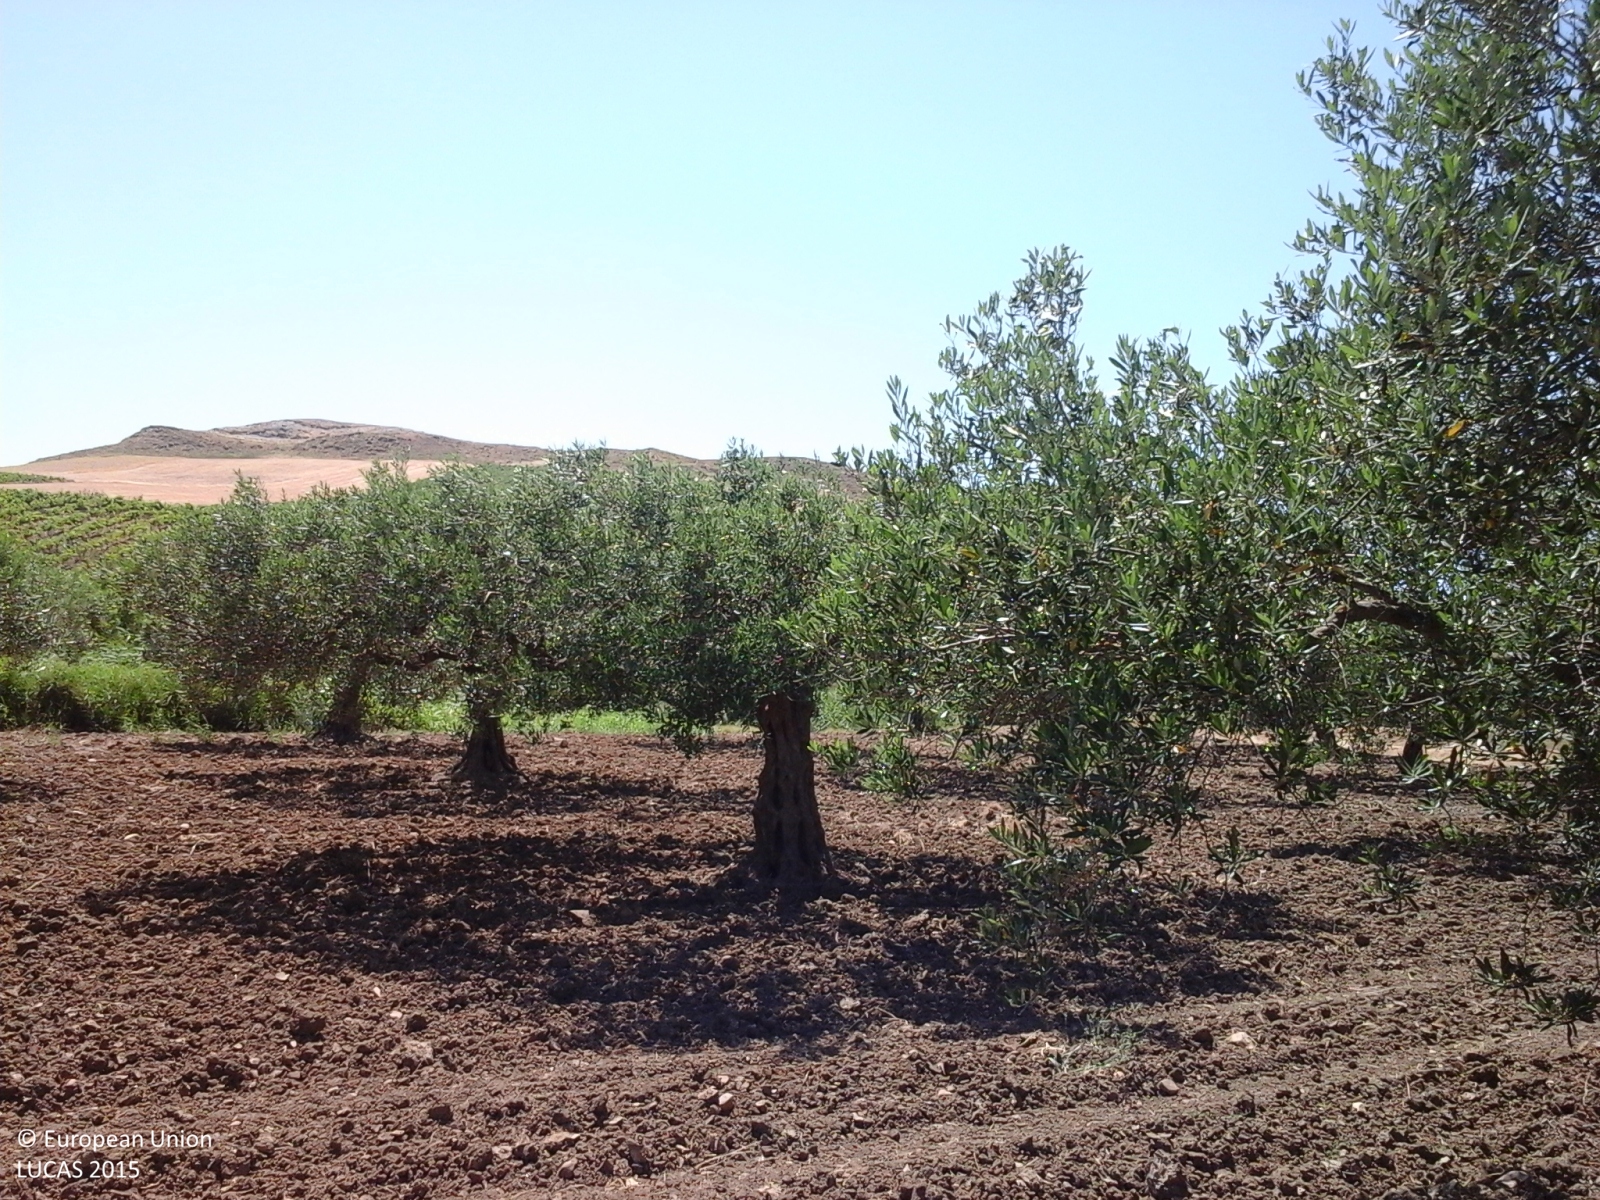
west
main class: Cropland
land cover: Olive groves
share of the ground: 50 - 75 %
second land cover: Other bare soil
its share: > 75 %
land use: Agriculture (excluding fallow land and kitchen gardens)
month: June
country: IT
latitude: 37.7801
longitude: 12.7612
